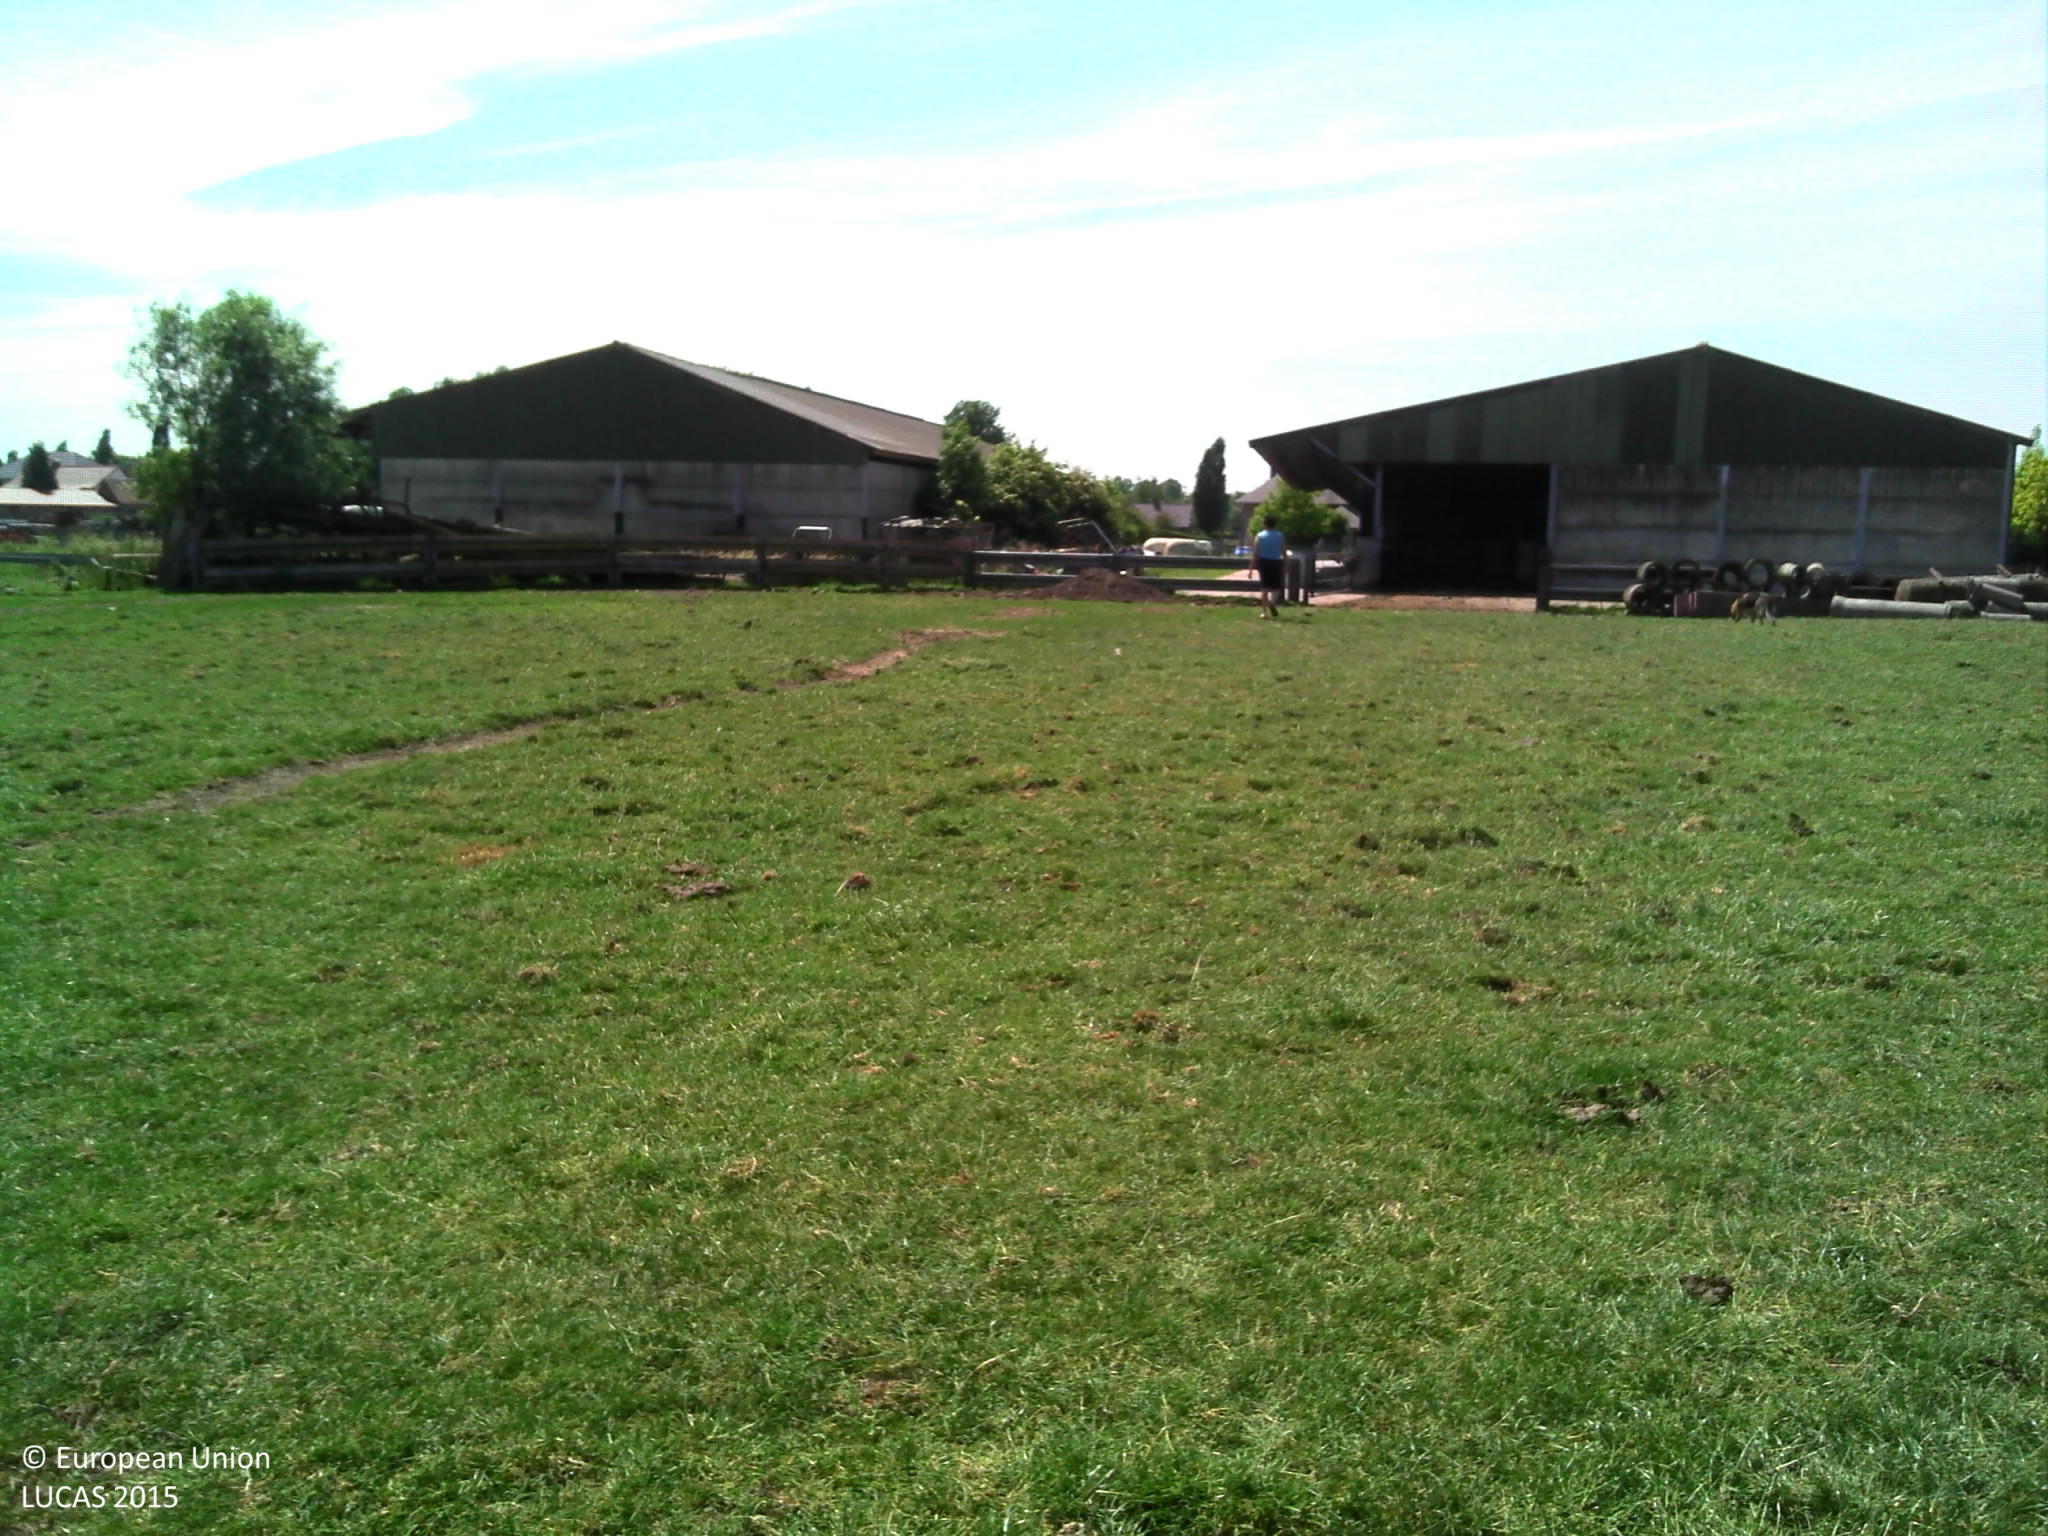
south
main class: Grassland
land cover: Grassland without tree/shrub cover
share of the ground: > 75 %
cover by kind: herbaceous plants 100 %
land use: Agriculture (excluding fallow land and kitchen gardens)
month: June
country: BE
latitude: 51.0950
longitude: 4.0972
